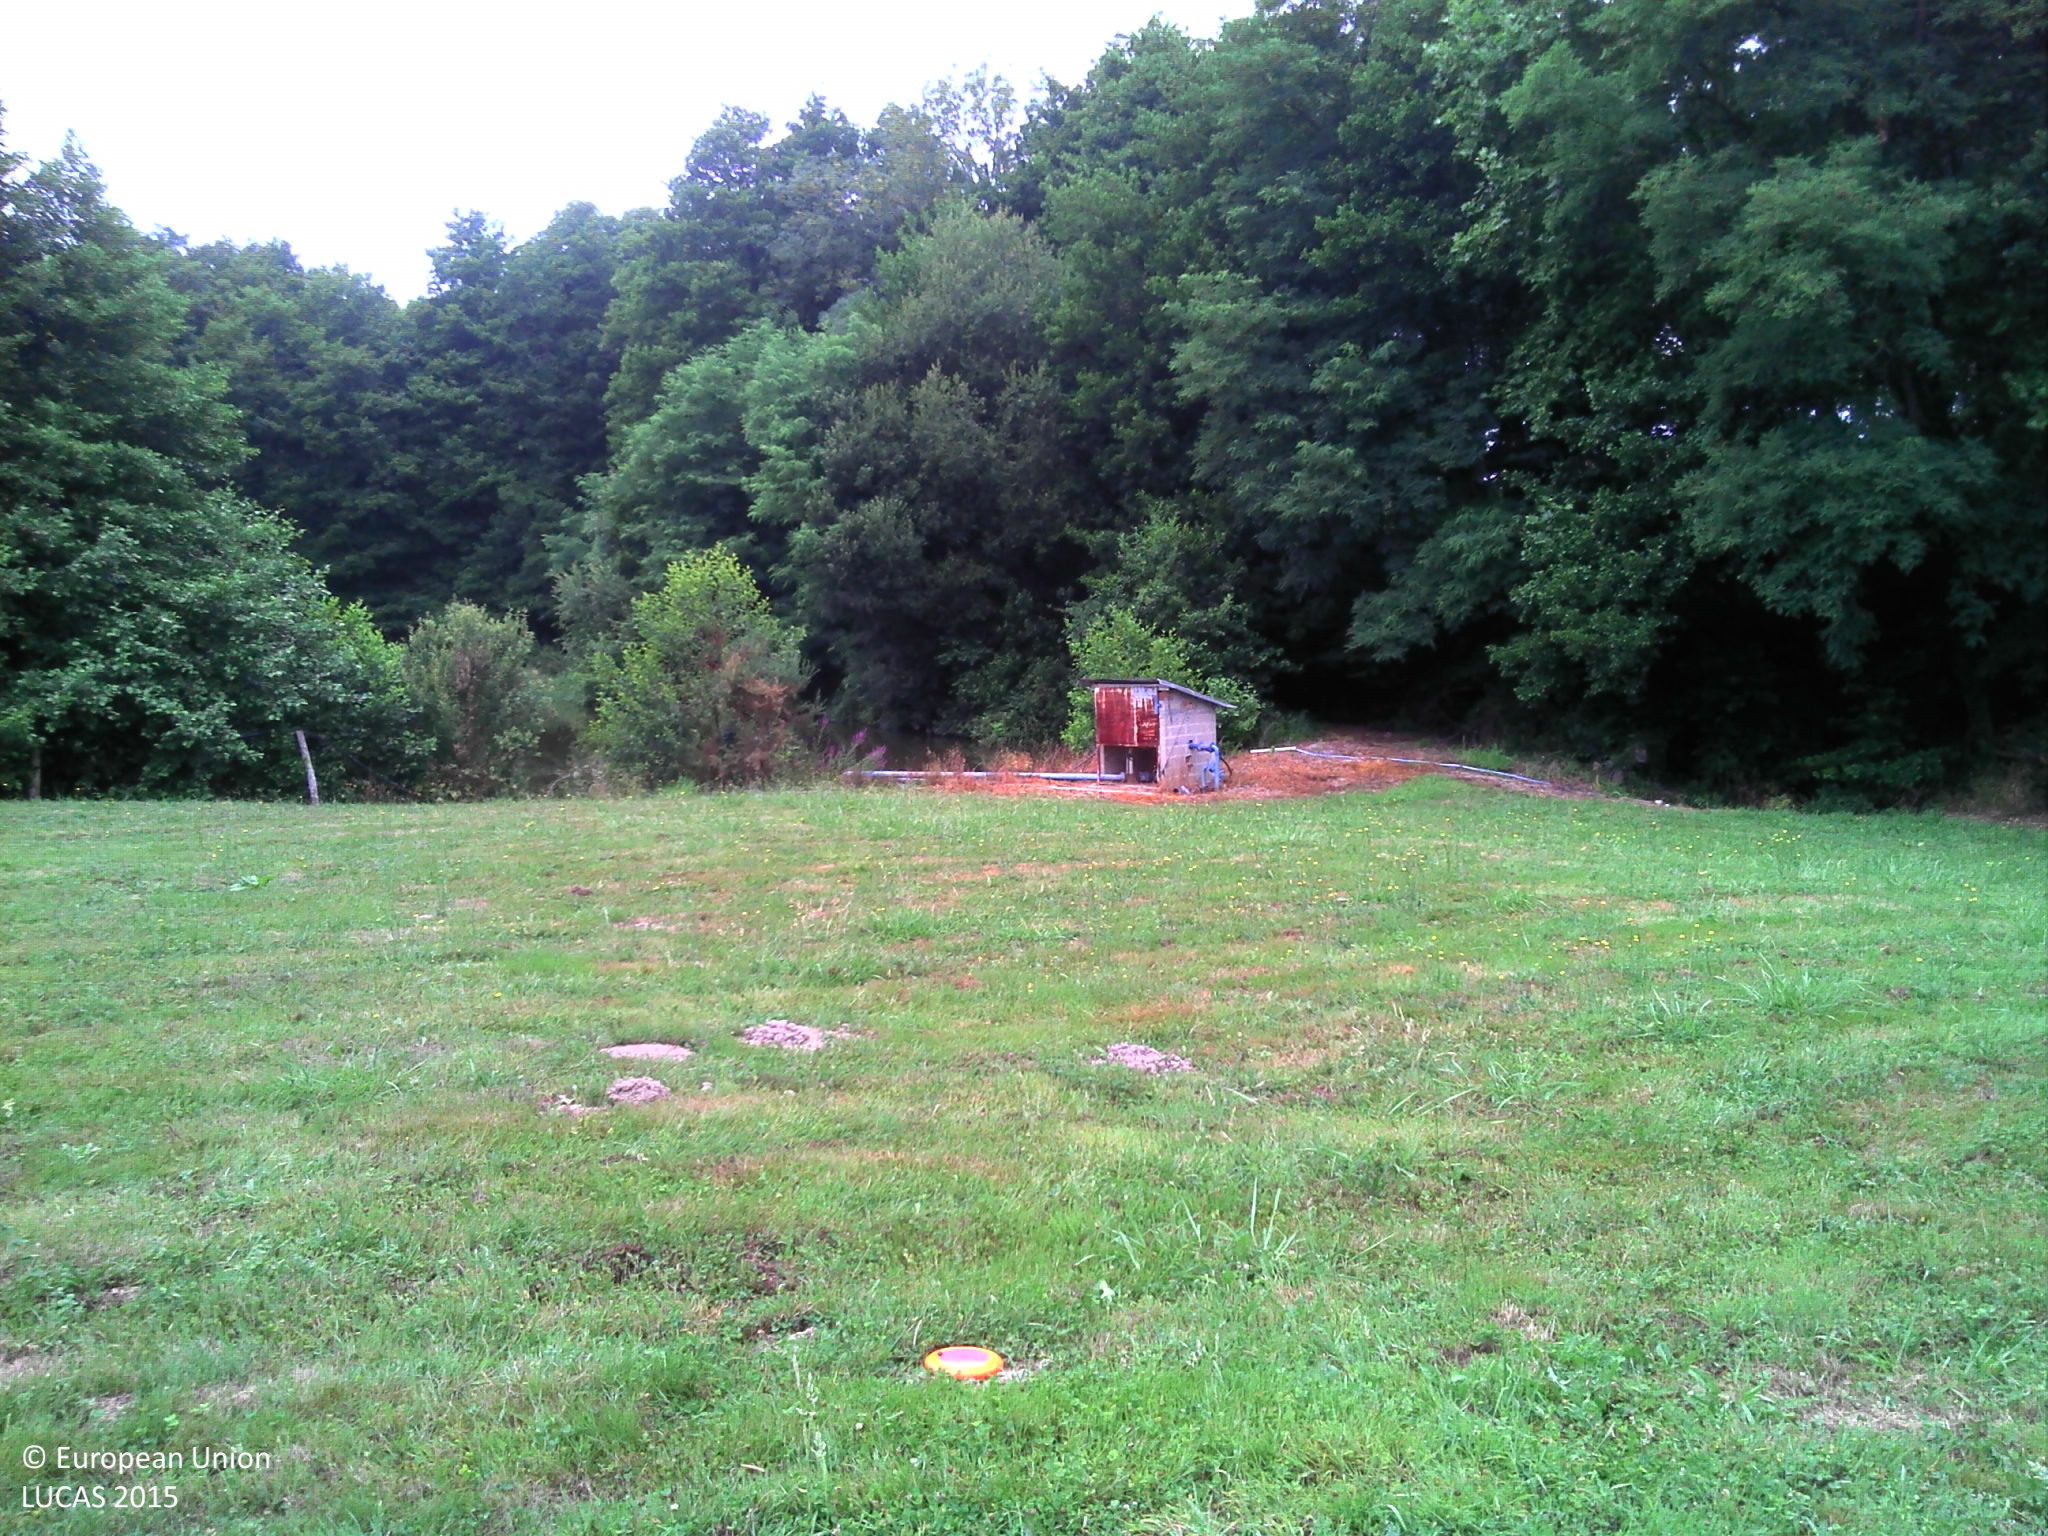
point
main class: Grassland
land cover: Grassland without tree/shrub cover
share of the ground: > 75 %
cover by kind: herbaceous plants 95 %, lichens and mosses 5 %
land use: Residential
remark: Clear cut
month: July
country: FR
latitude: 43.5554
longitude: -1.2440
